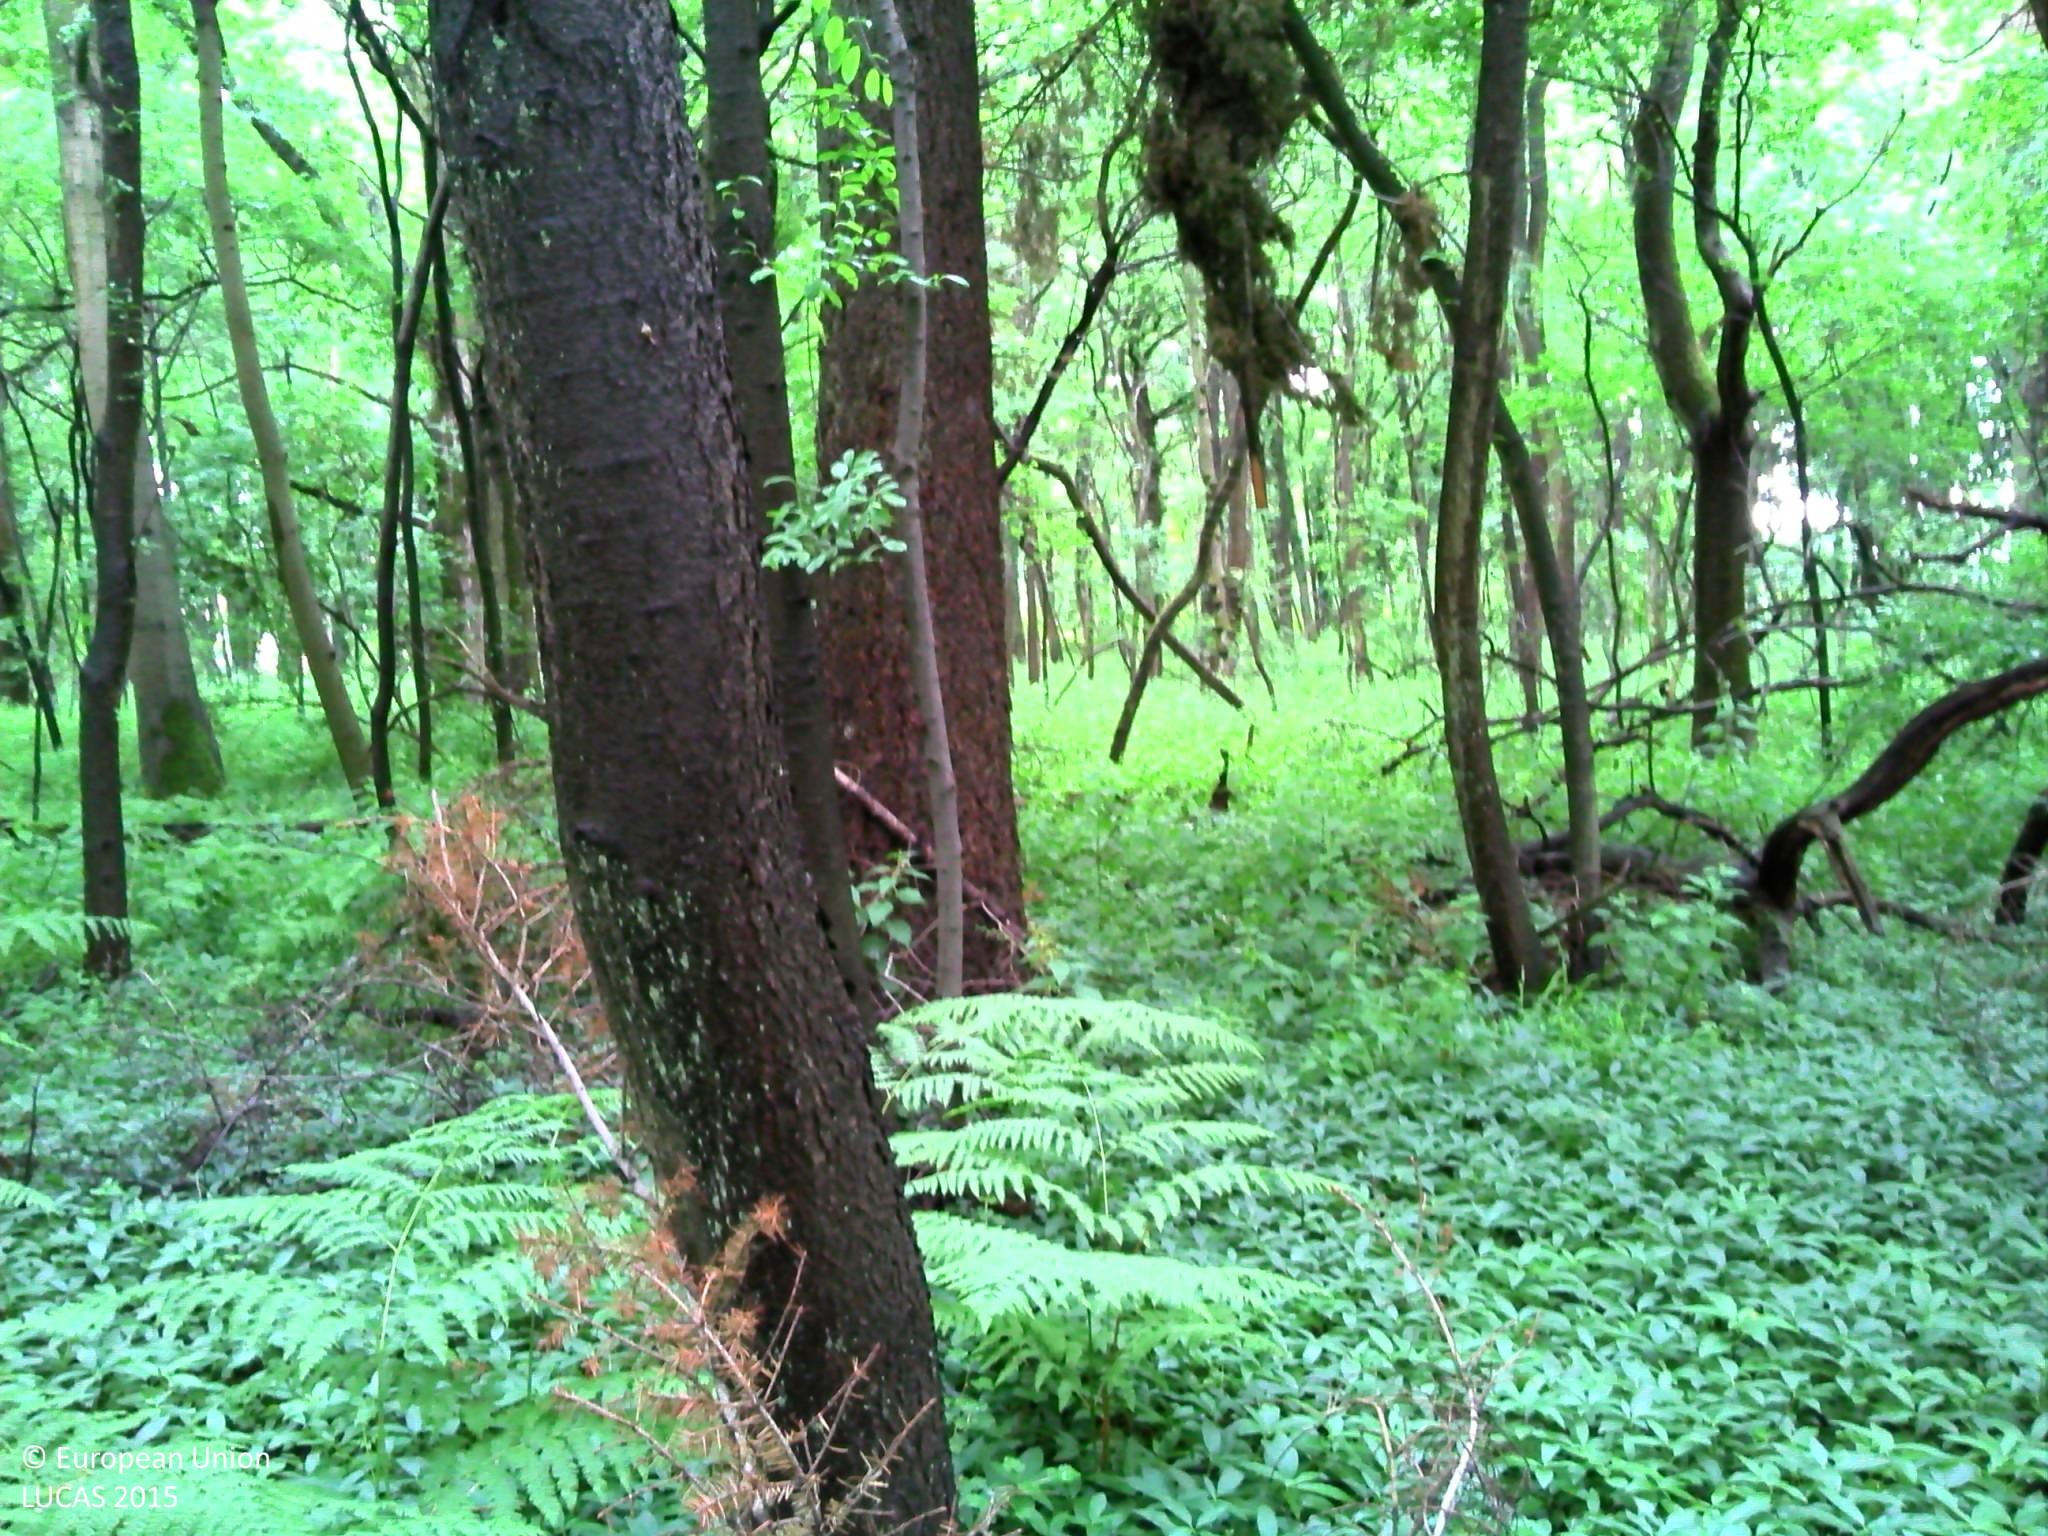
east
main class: Woodland
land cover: Broadleaved woodland
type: mesophytic deciduous forest
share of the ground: > 75 %
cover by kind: broadleaved forest trees 75 %, herbaceous plants 20 %, shrubs 5 %
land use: Forestry
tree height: > 5 m
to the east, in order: Broadleaved woodland; Grass margins; Paved roads, cycling and walking lanes; Grass margins; Electric lines; Grassland without tree/shrub cover; Broadleaved woodland; Grassland without tree/shrub cover
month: June
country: BE
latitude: 50.4952
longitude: 4.0031
